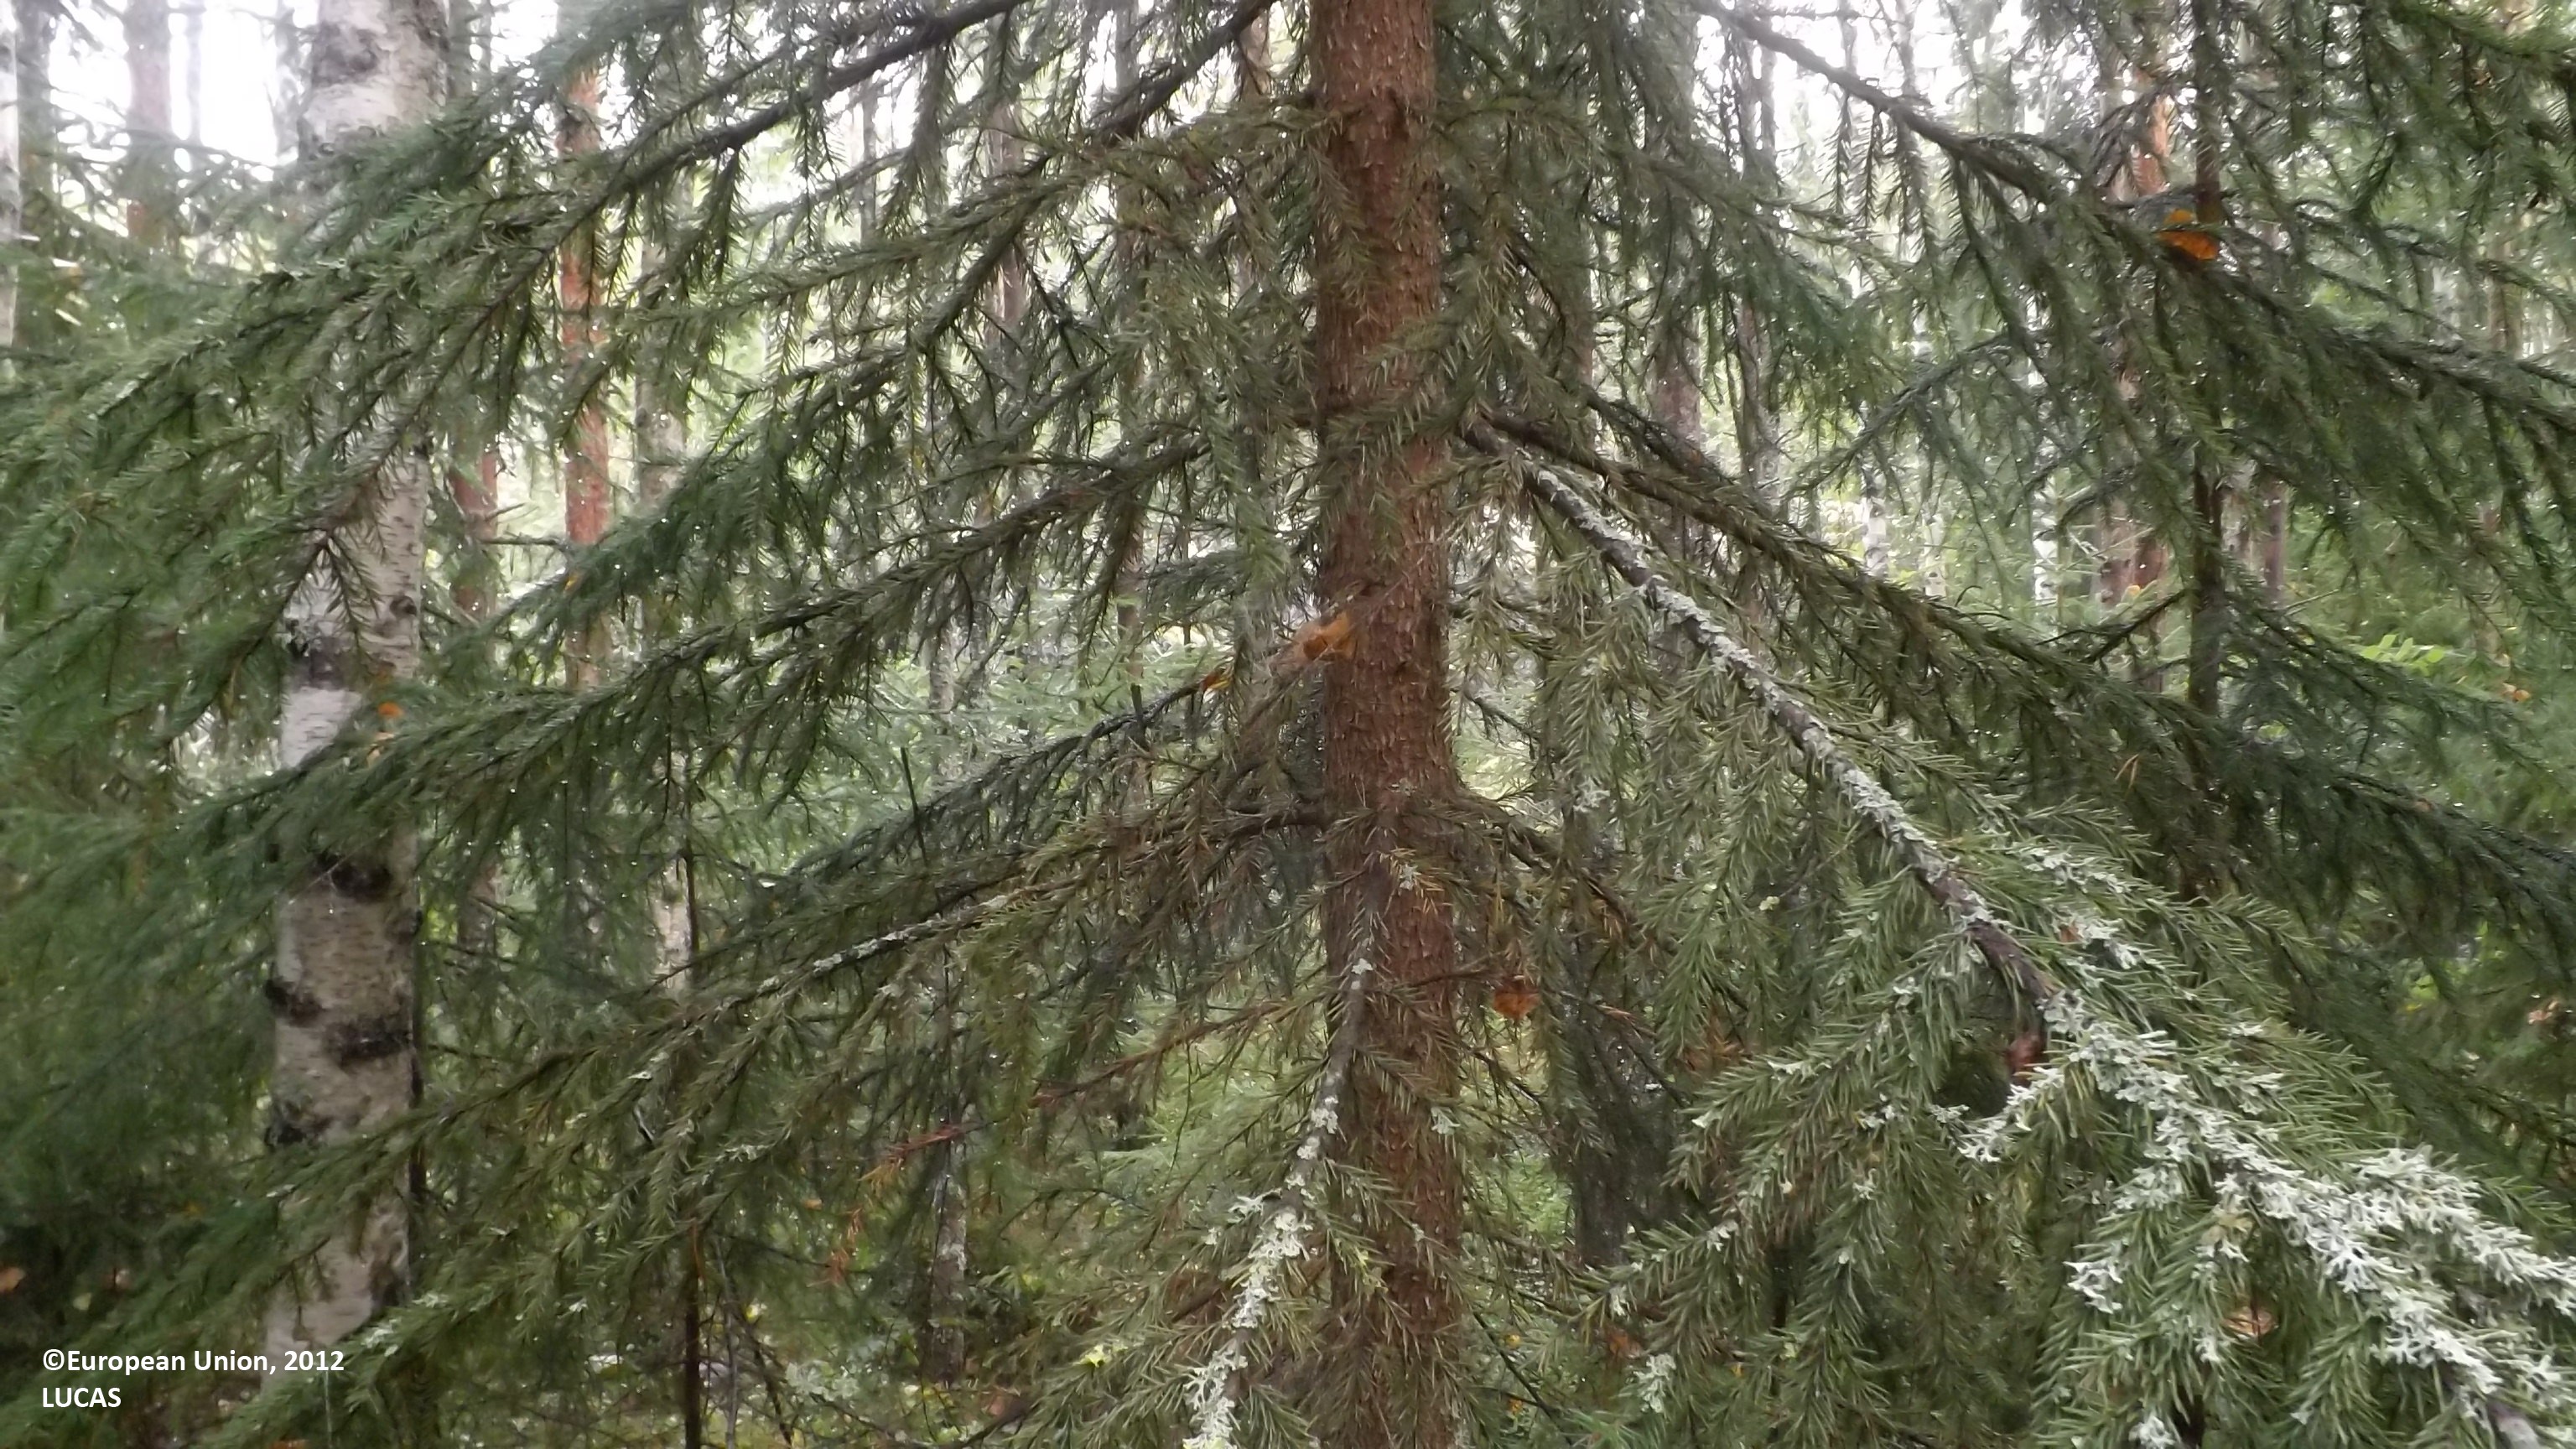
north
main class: Woodland
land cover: Other mixed woodland
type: boreal forest
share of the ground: > 75 %
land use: Forestry
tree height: > 5 m
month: August
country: FI
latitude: 63.8932
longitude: 23.4804
